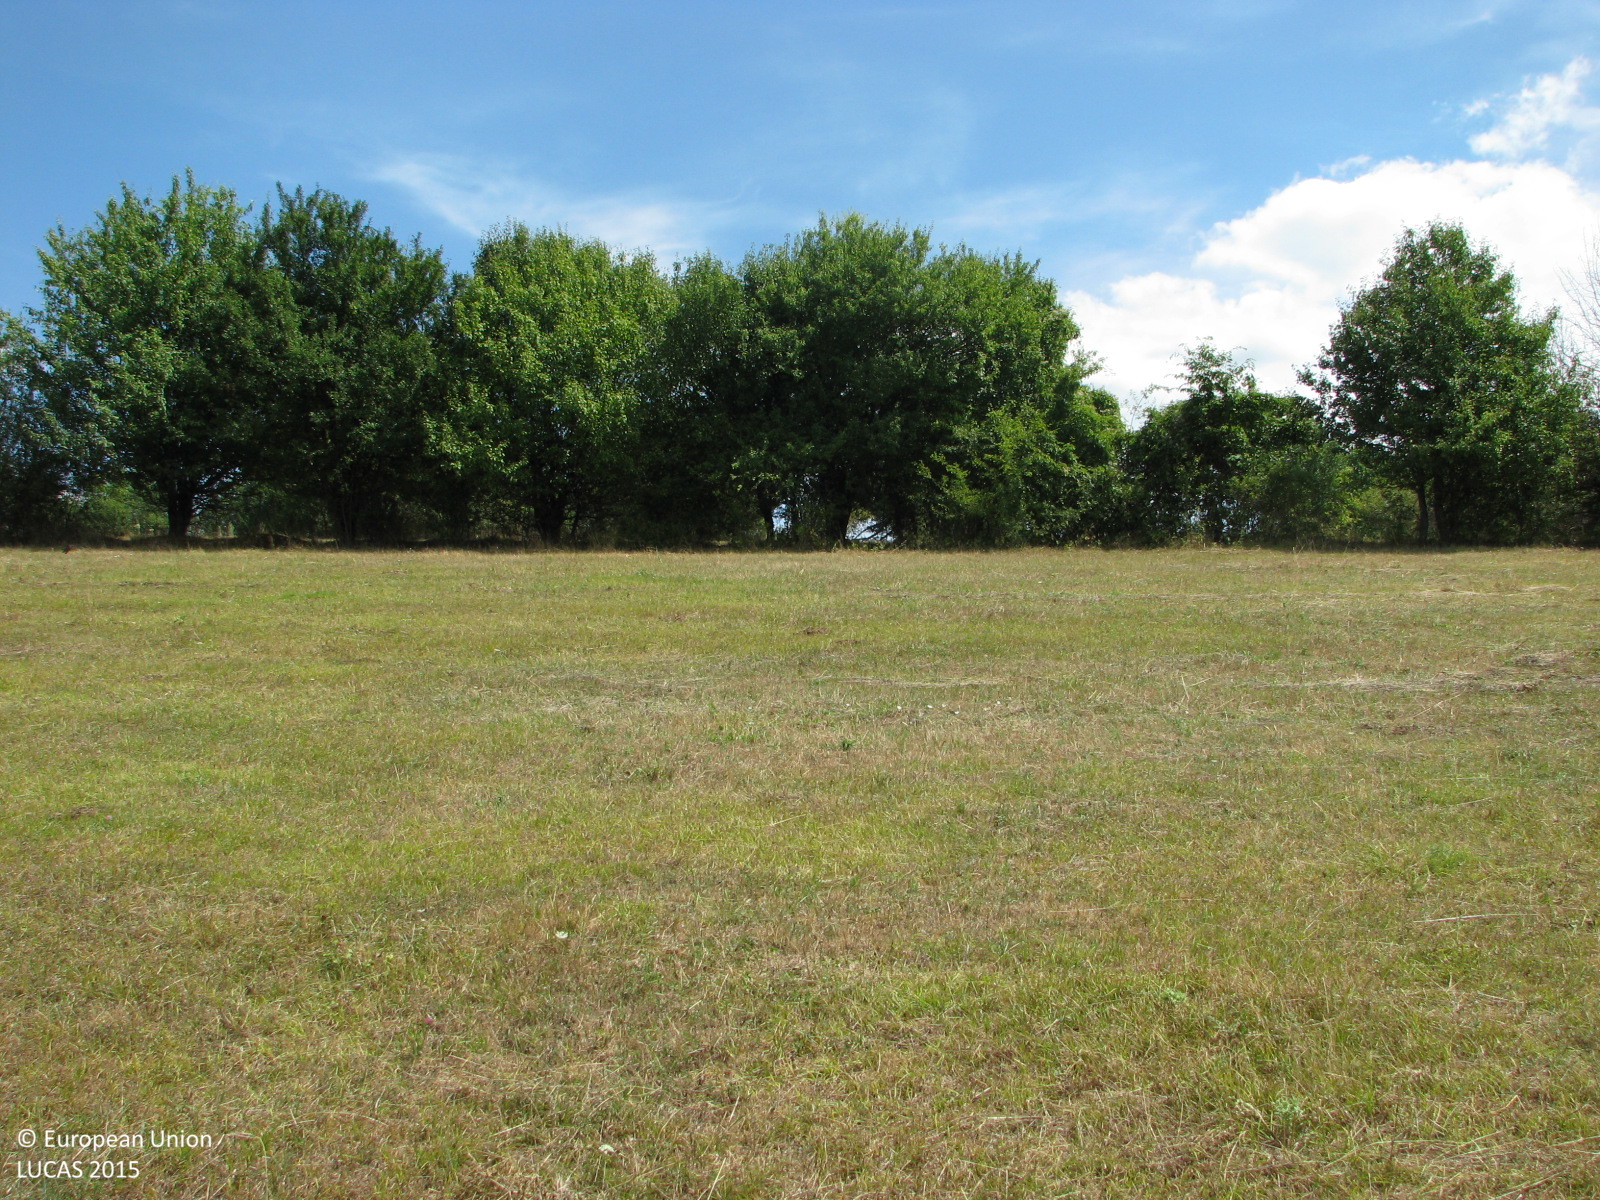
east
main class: Grassland
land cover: Grassland without tree/shrub cover
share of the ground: > 75 %
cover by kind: herbaceous plants 100 %
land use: Agriculture (excluding fallow land and kitchen gardens)
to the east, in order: Grassland without tree/shrub cover; Abandoned hedges; Grassland without tree/shrub cover; Abandoned hedges; Grassland without tree/shrub cover; Abandoned hedges; Grassland without tree/shrub cover; Artificial constructions in urban areas; Grassland without tree/shrub cover
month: August
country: BG
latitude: 42.9691
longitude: 26.2392
